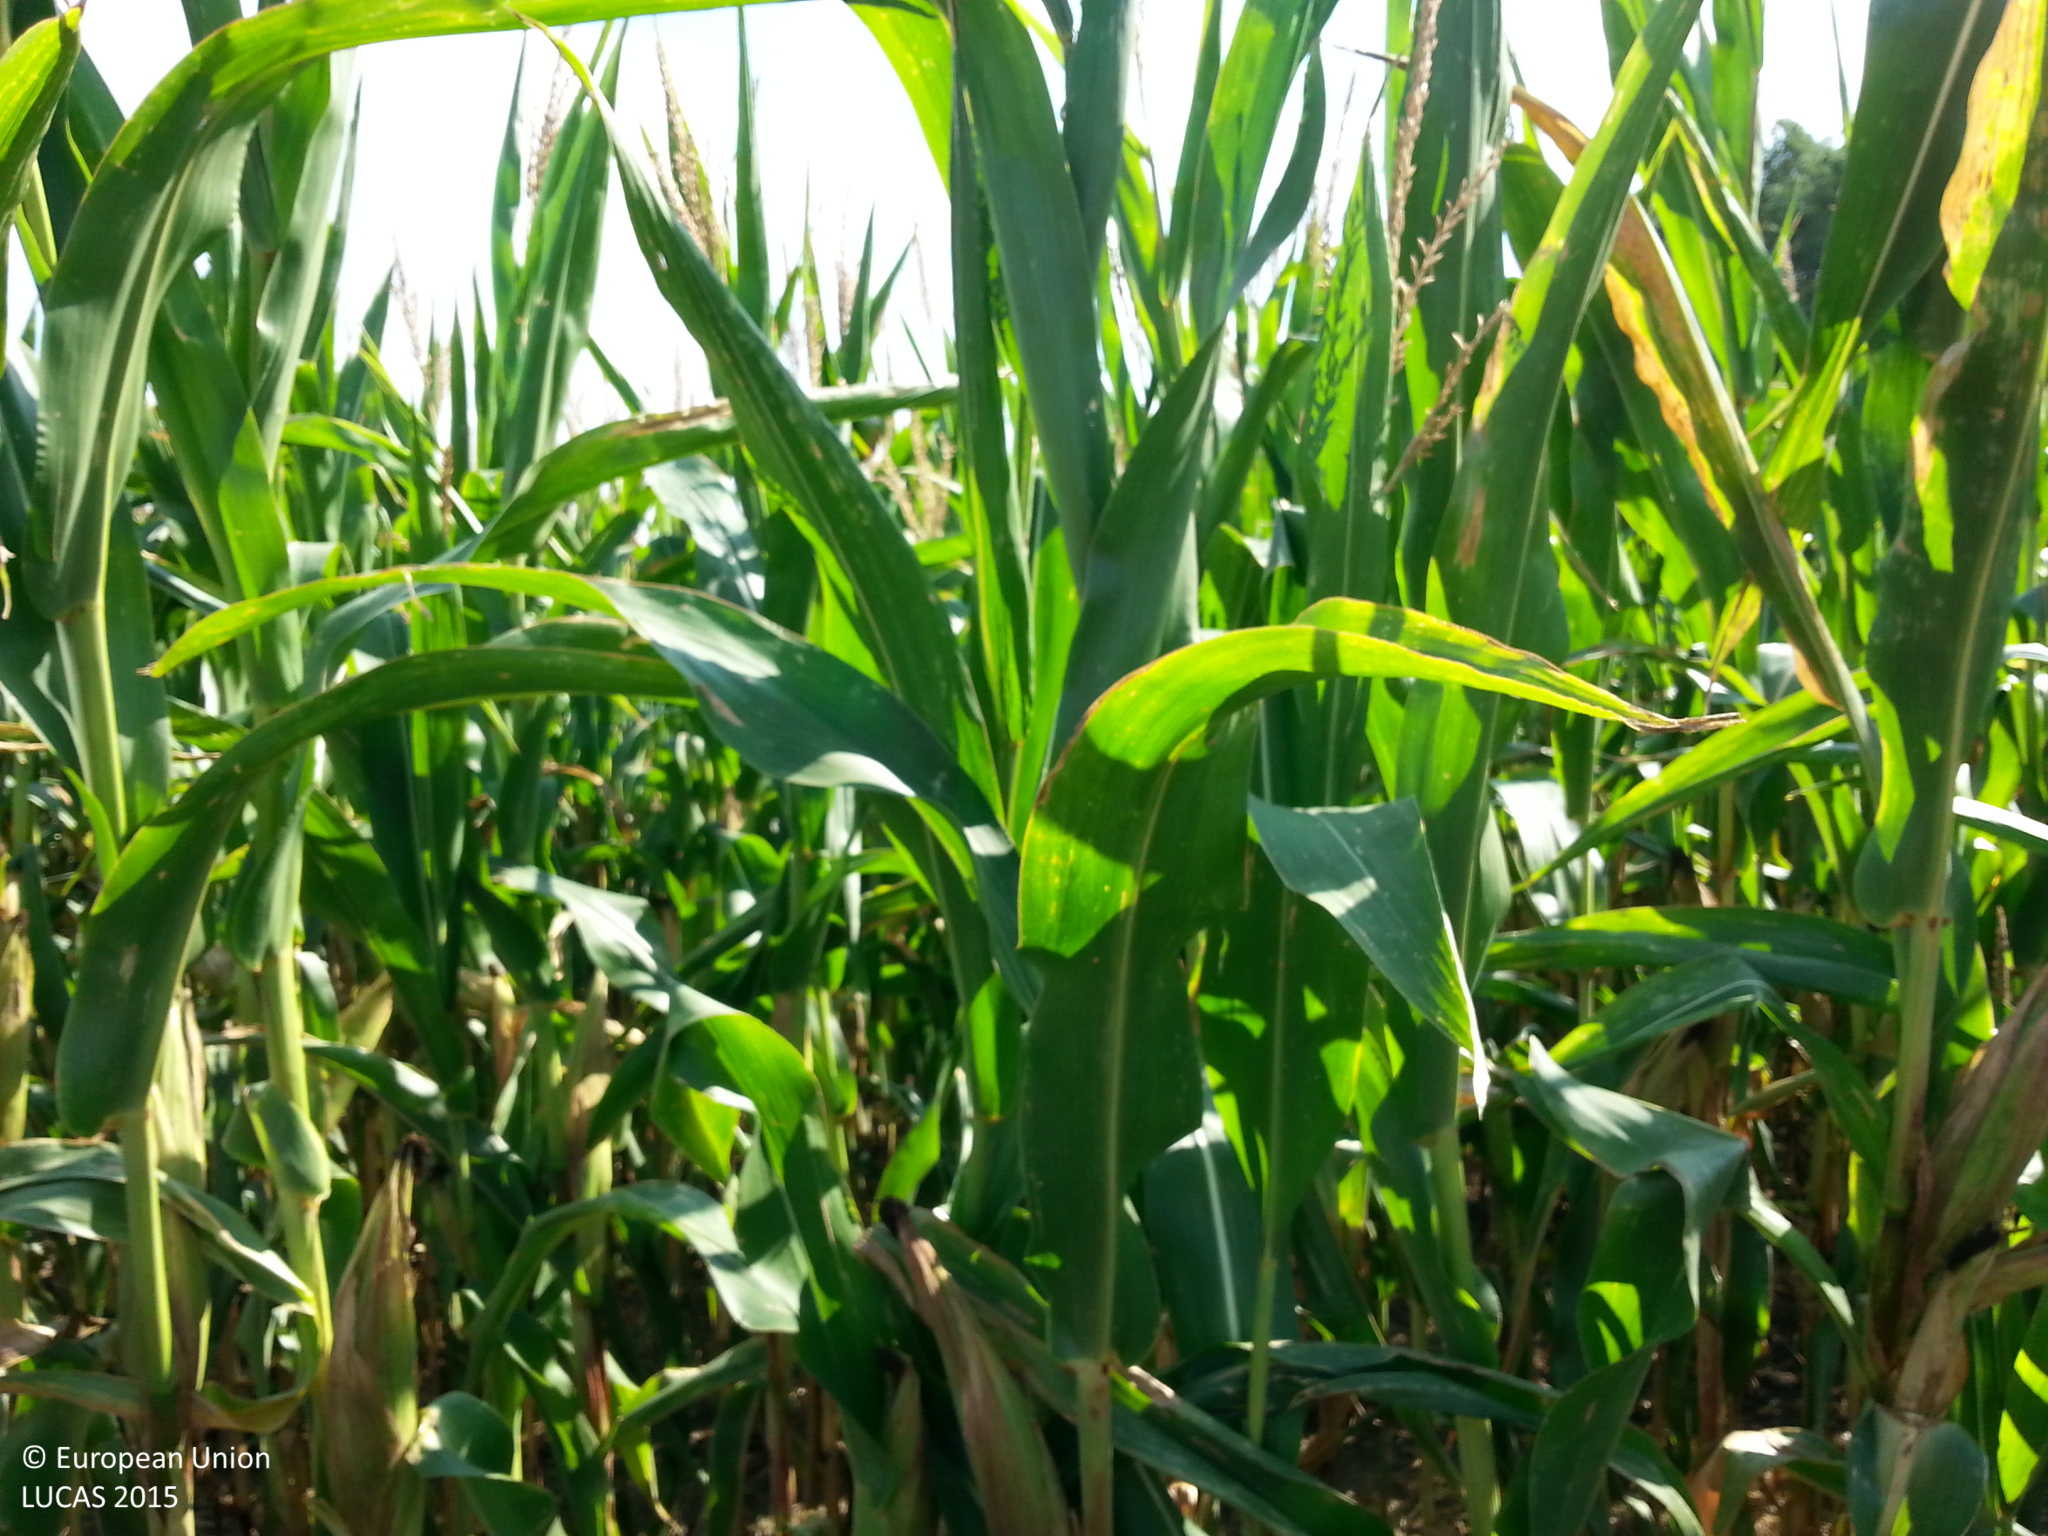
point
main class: Cropland
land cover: Maize
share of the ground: > 75 %
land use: Agriculture (excluding fallow land and kitchen gardens)
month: September
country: DE
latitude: 49.3569
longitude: 9.9037
